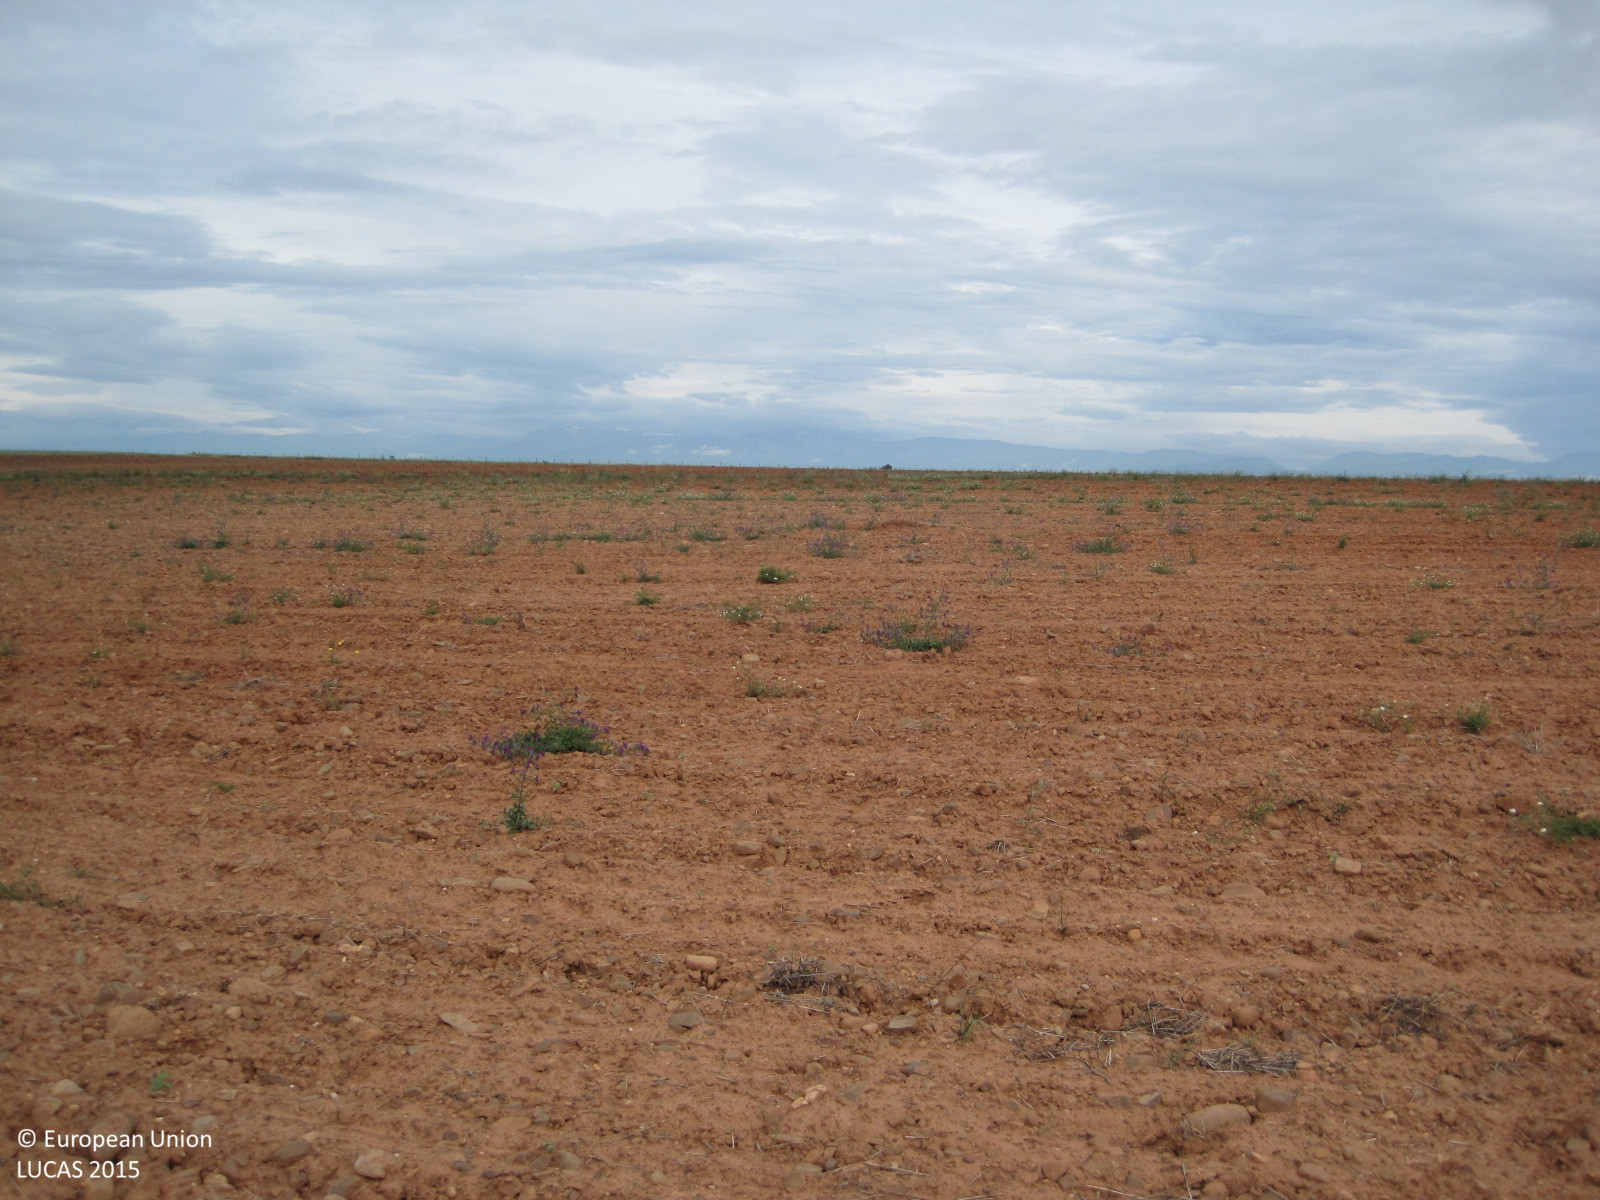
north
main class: Cropland
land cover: Sunflower
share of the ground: < 10 %
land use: Agriculture (excluding fallow land and kitchen gardens)
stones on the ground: 25 - 50 %
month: May
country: ES
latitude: 39.9164
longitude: -4.7515
